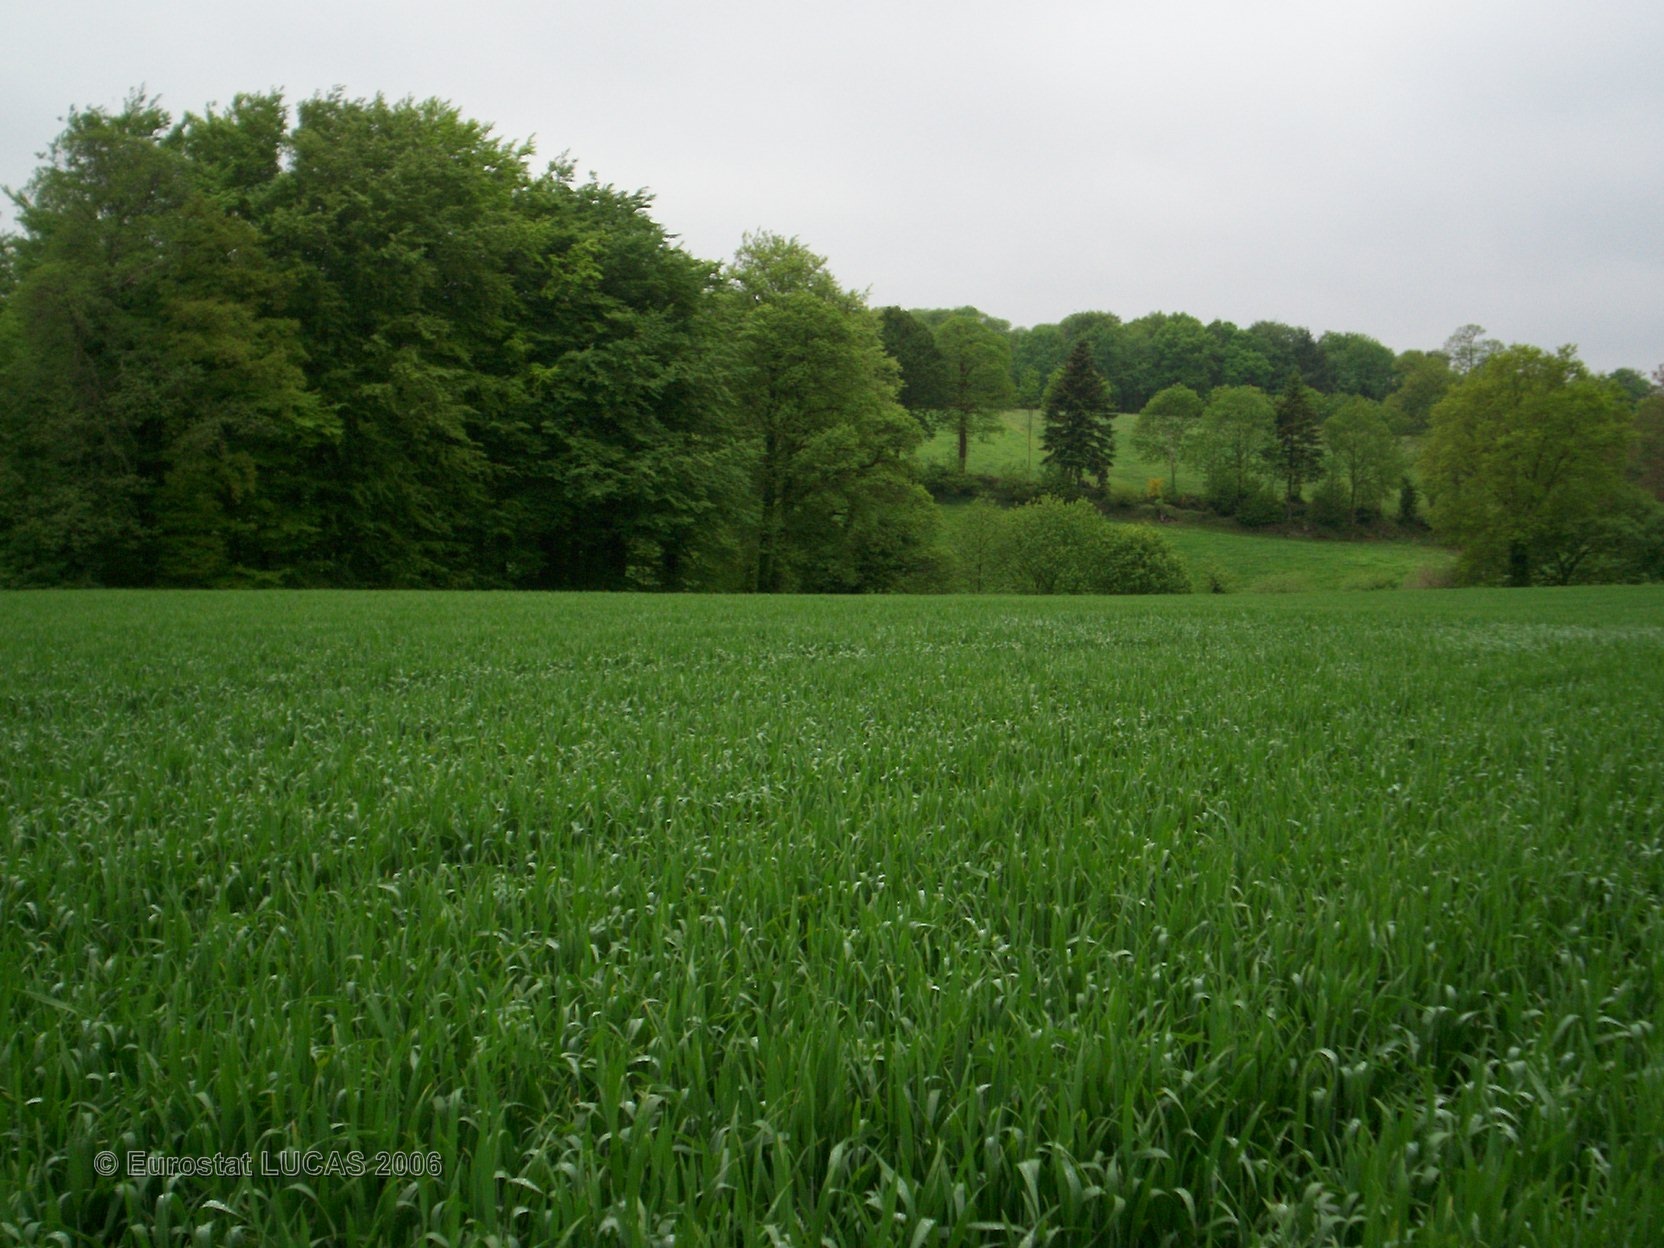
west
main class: Cropland
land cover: Common wheat
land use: Agriculture (excluding fallow land and kitchen gardens)
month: May
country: FR
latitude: 48.4121
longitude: -1.2161
